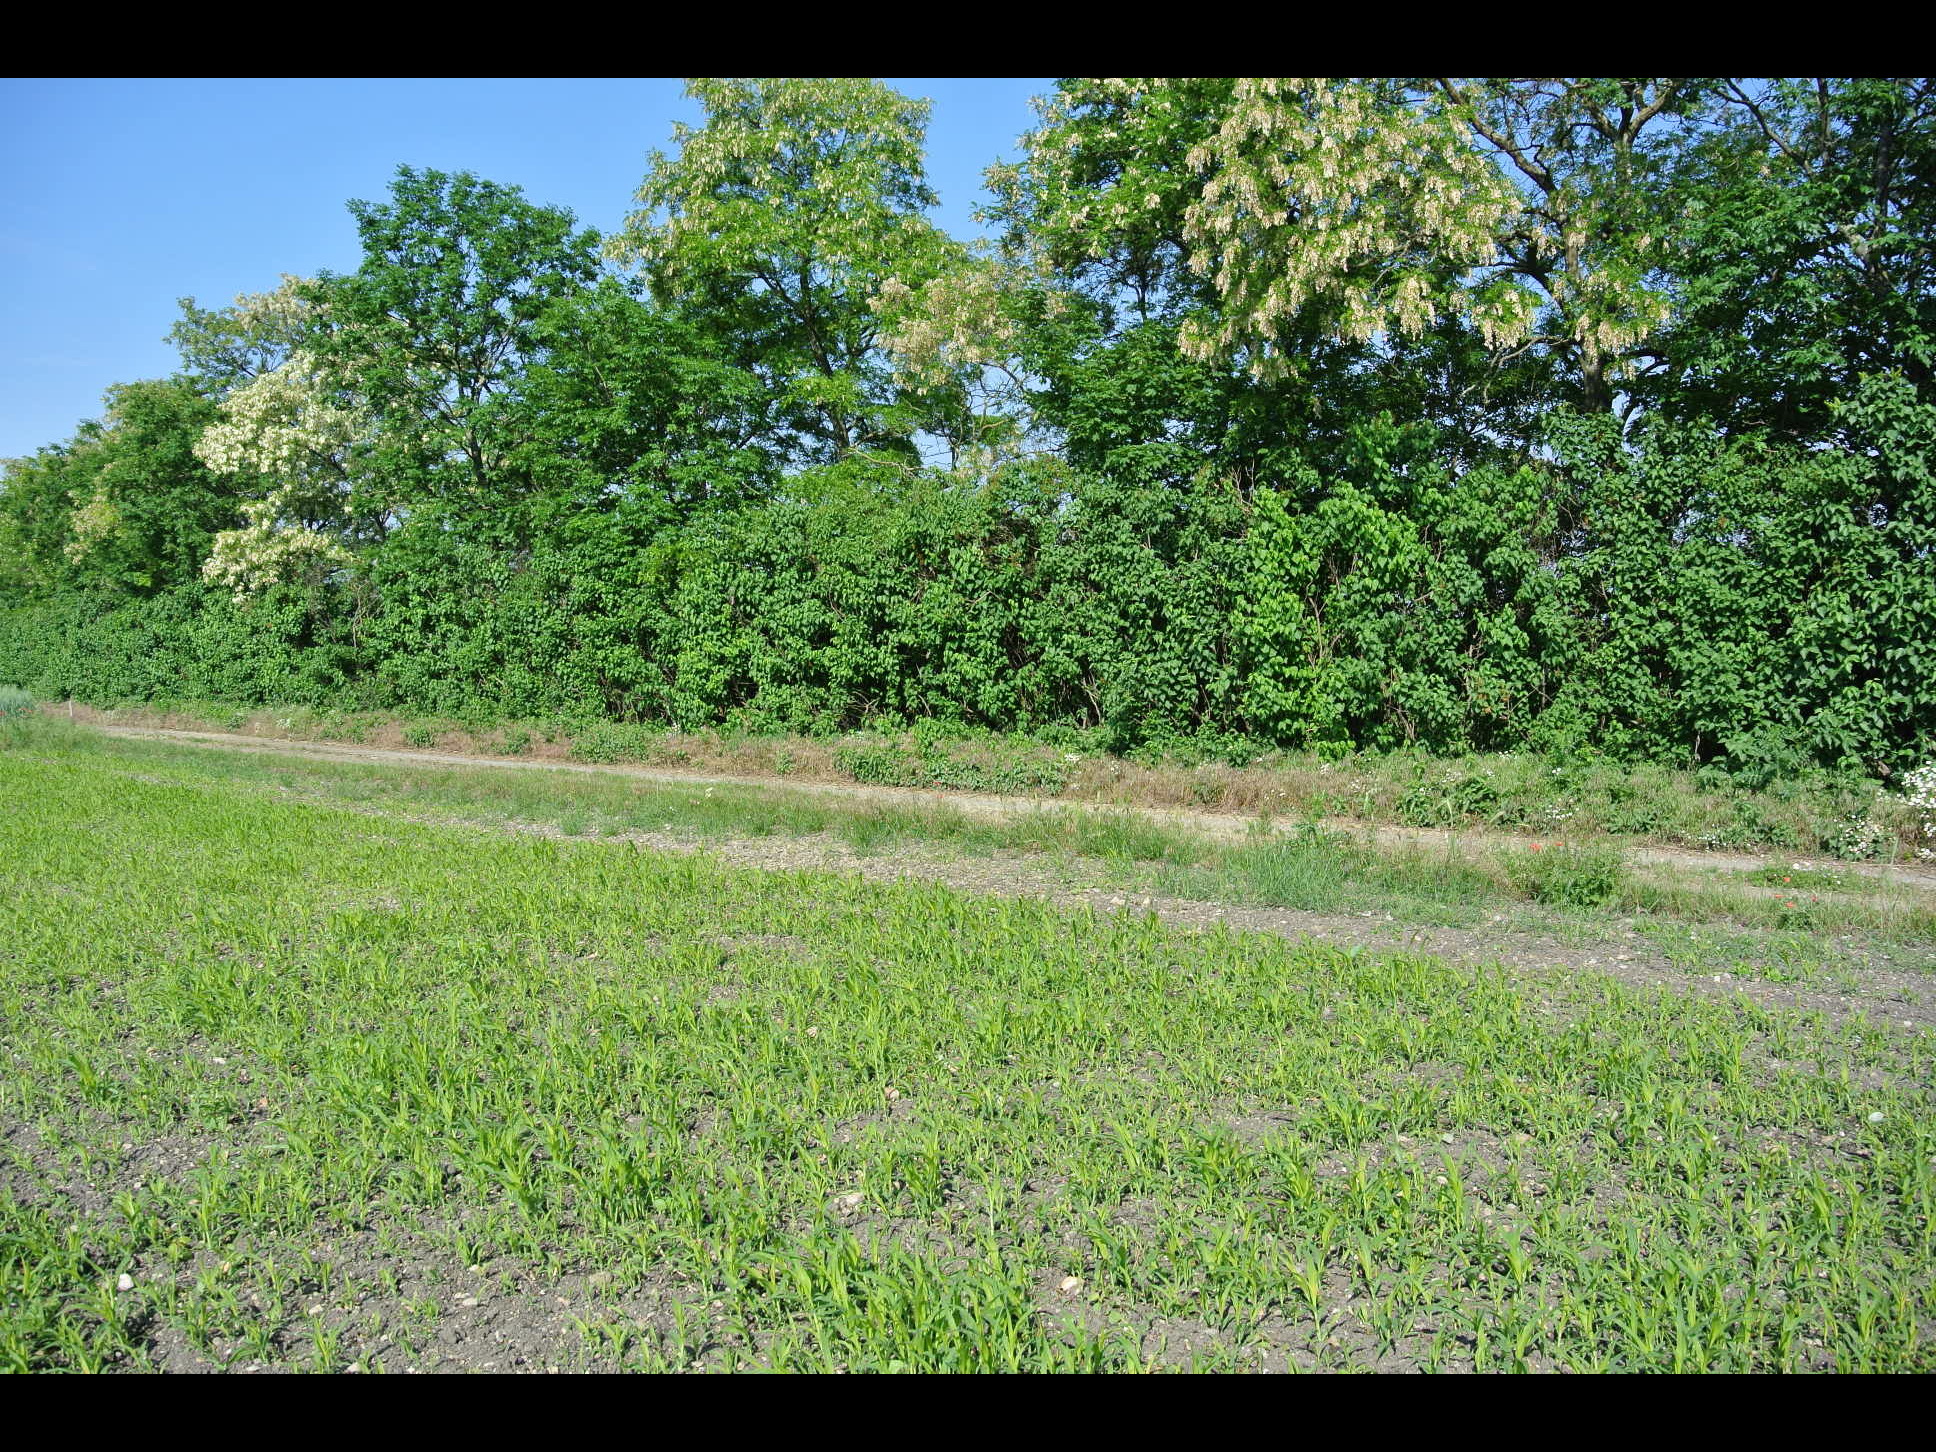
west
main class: Cropland
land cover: Maize
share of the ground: > 75 %
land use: Agriculture (excluding fallow land and kitchen gardens)
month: May
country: AT
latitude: 47.9790
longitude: 16.4757
